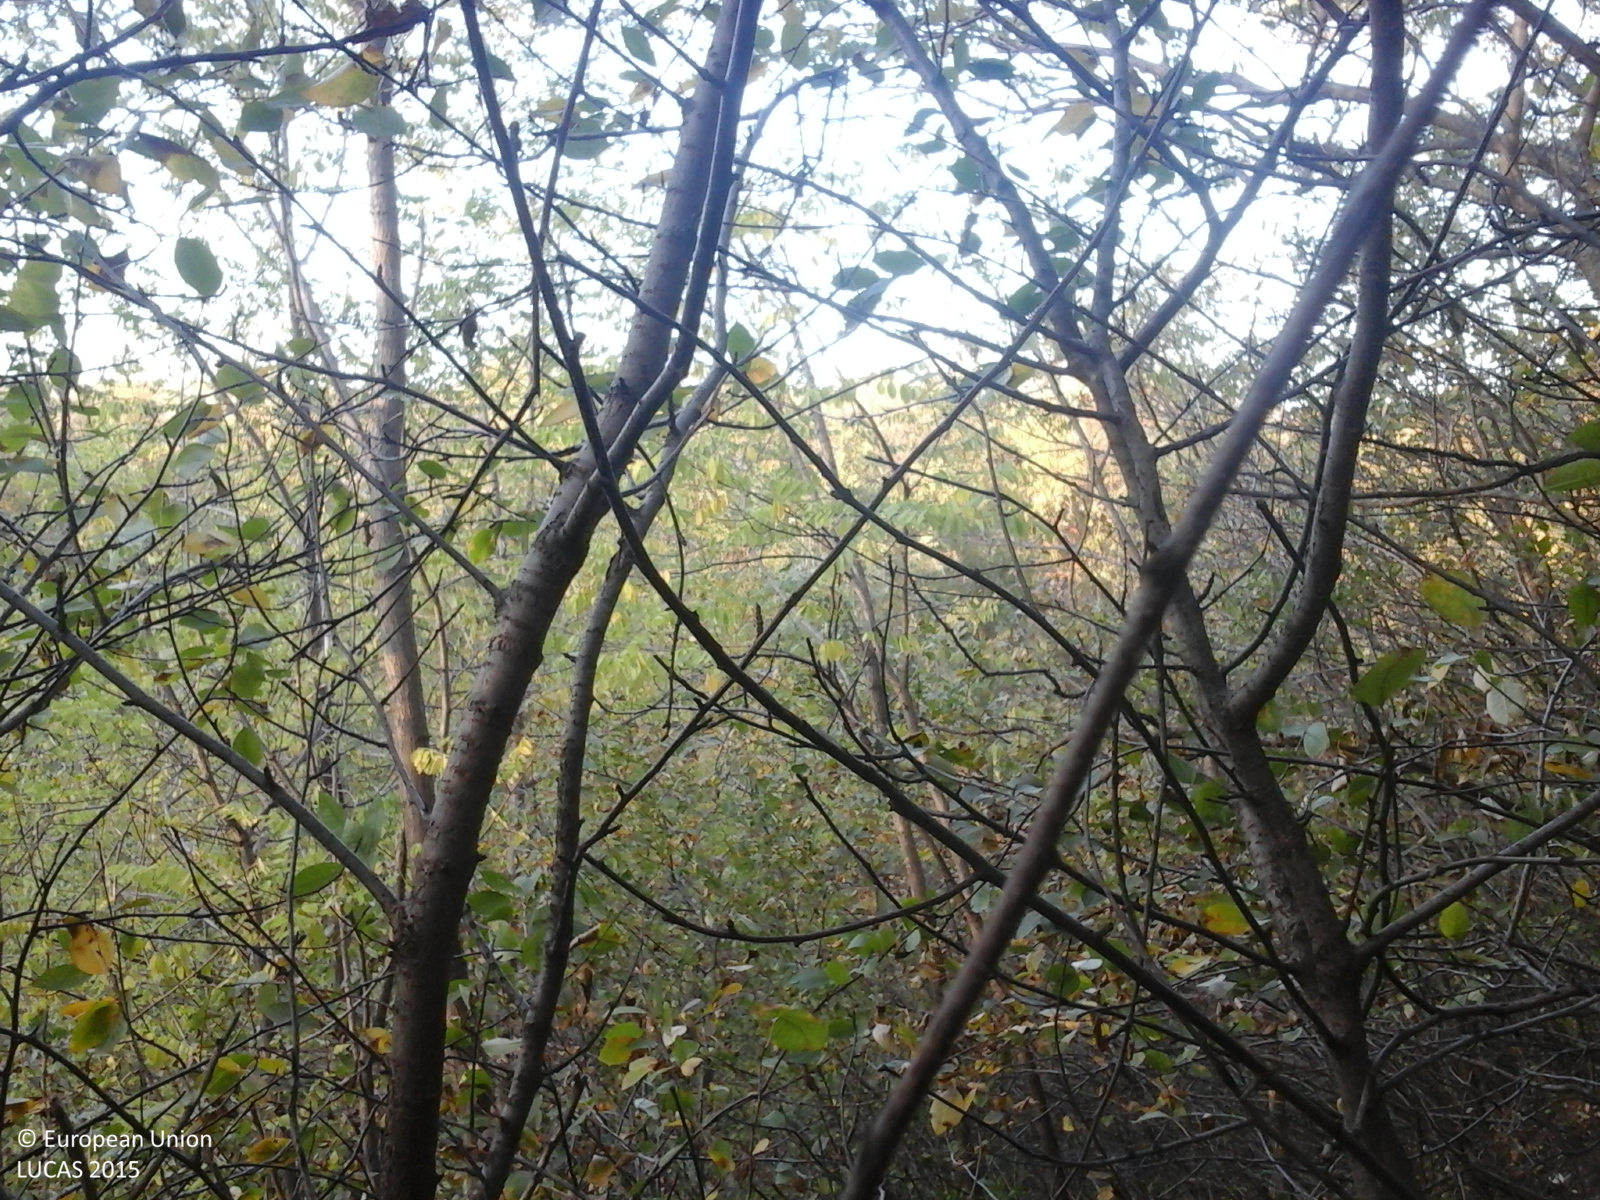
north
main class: Woodland
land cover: Broadleaved woodland
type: exotic forest
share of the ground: > 75 %
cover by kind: broadleaved forest trees 100 %
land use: Forestry
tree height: > 5 m
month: October
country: RO
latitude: 45.4723
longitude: 27.0109
